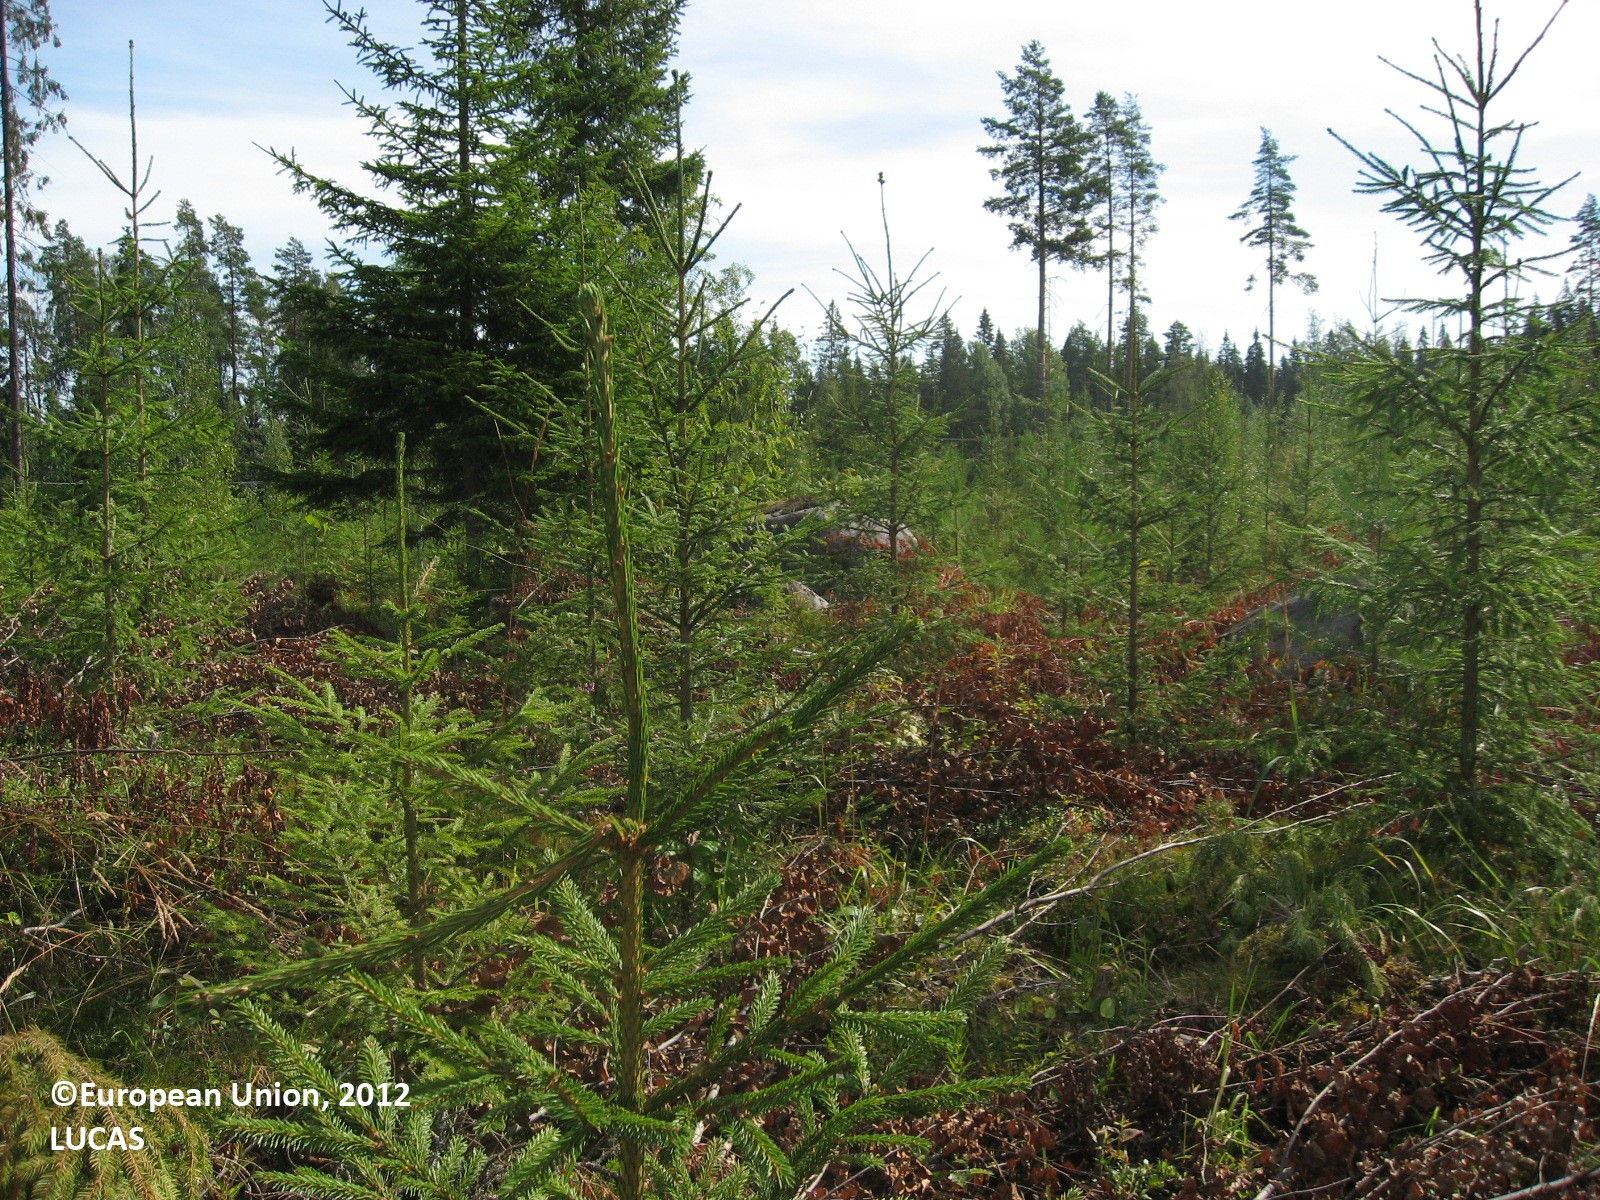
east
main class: Woodland
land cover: Spruce dominated coniferous woodland
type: boreal forest
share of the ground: 25 - 50 %
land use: Forestry
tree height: < 5 m
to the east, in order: Spruce dominated coniferous woodland; Spruce dominated mixed woodland; Electric lines; Grass margins; Paved roads, cycling and walking lanes; Spontaneously vegetated surfaces; Electric lines; Spontaneously vegetated surfaces; Spruce dominated mixed woodland; Fences; Grassland with sparse tree/shrub cover; Fences; Spruce dominated mixed woodland
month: August
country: FI
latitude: 61.5816
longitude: 24.9697
